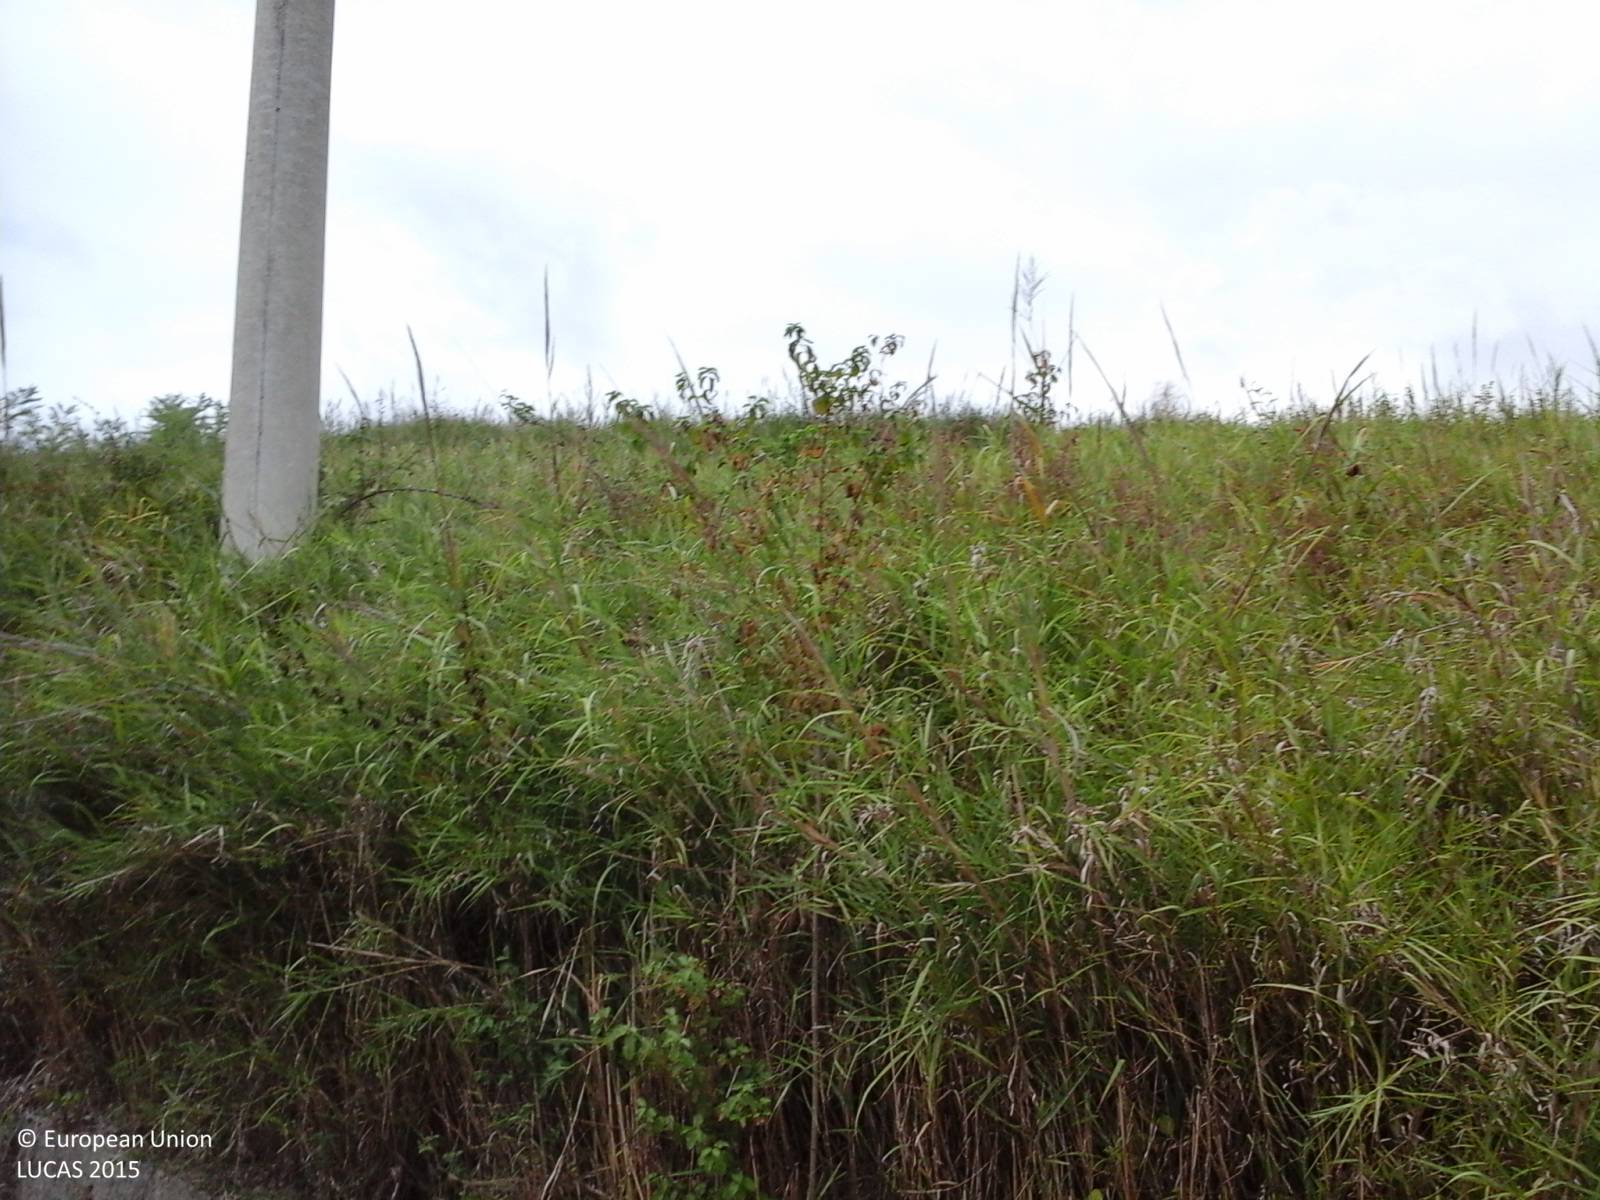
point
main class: Grassland
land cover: Grassland without tree/shrub cover
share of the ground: > 75 %
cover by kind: herbaceous plants 100 %
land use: Abandoned areas
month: September
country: IT
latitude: 42.4266
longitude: 12.4106
